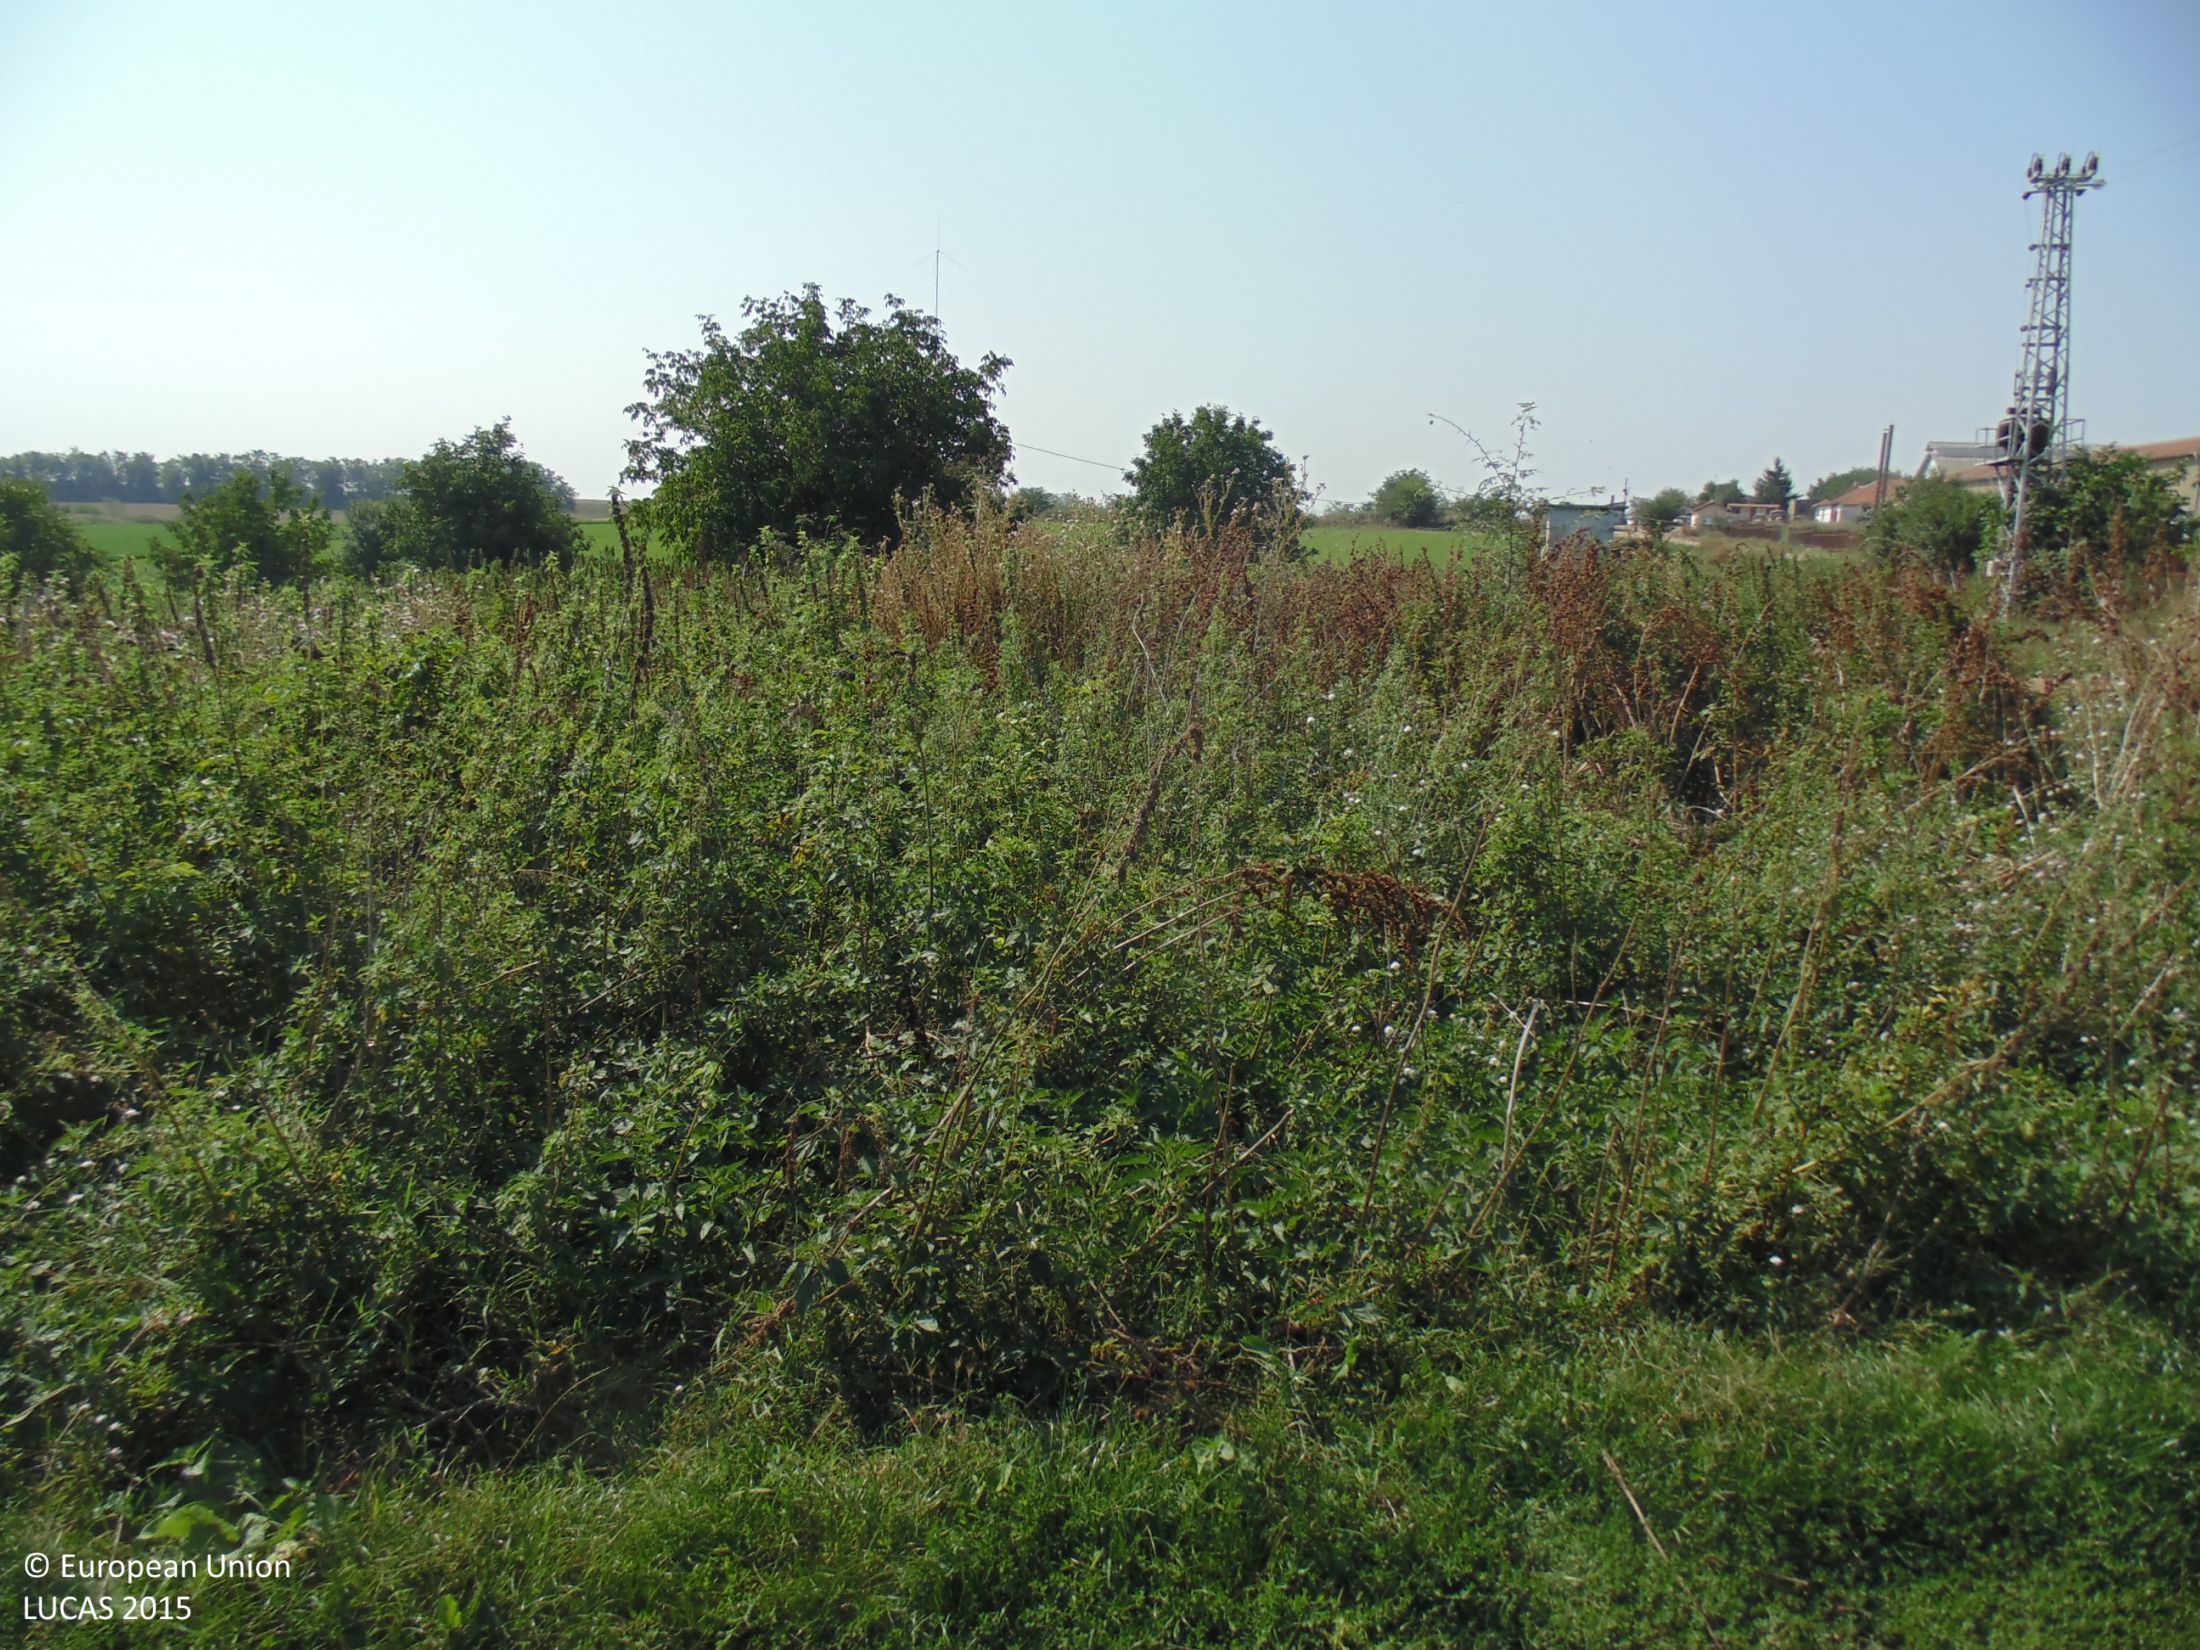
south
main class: Grassland
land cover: Spontaneously vegetated surfaces
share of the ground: > 75 %
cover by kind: herbaceous plants 100 %
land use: Residential
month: September
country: BG
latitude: 43.7415
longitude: 27.0205
